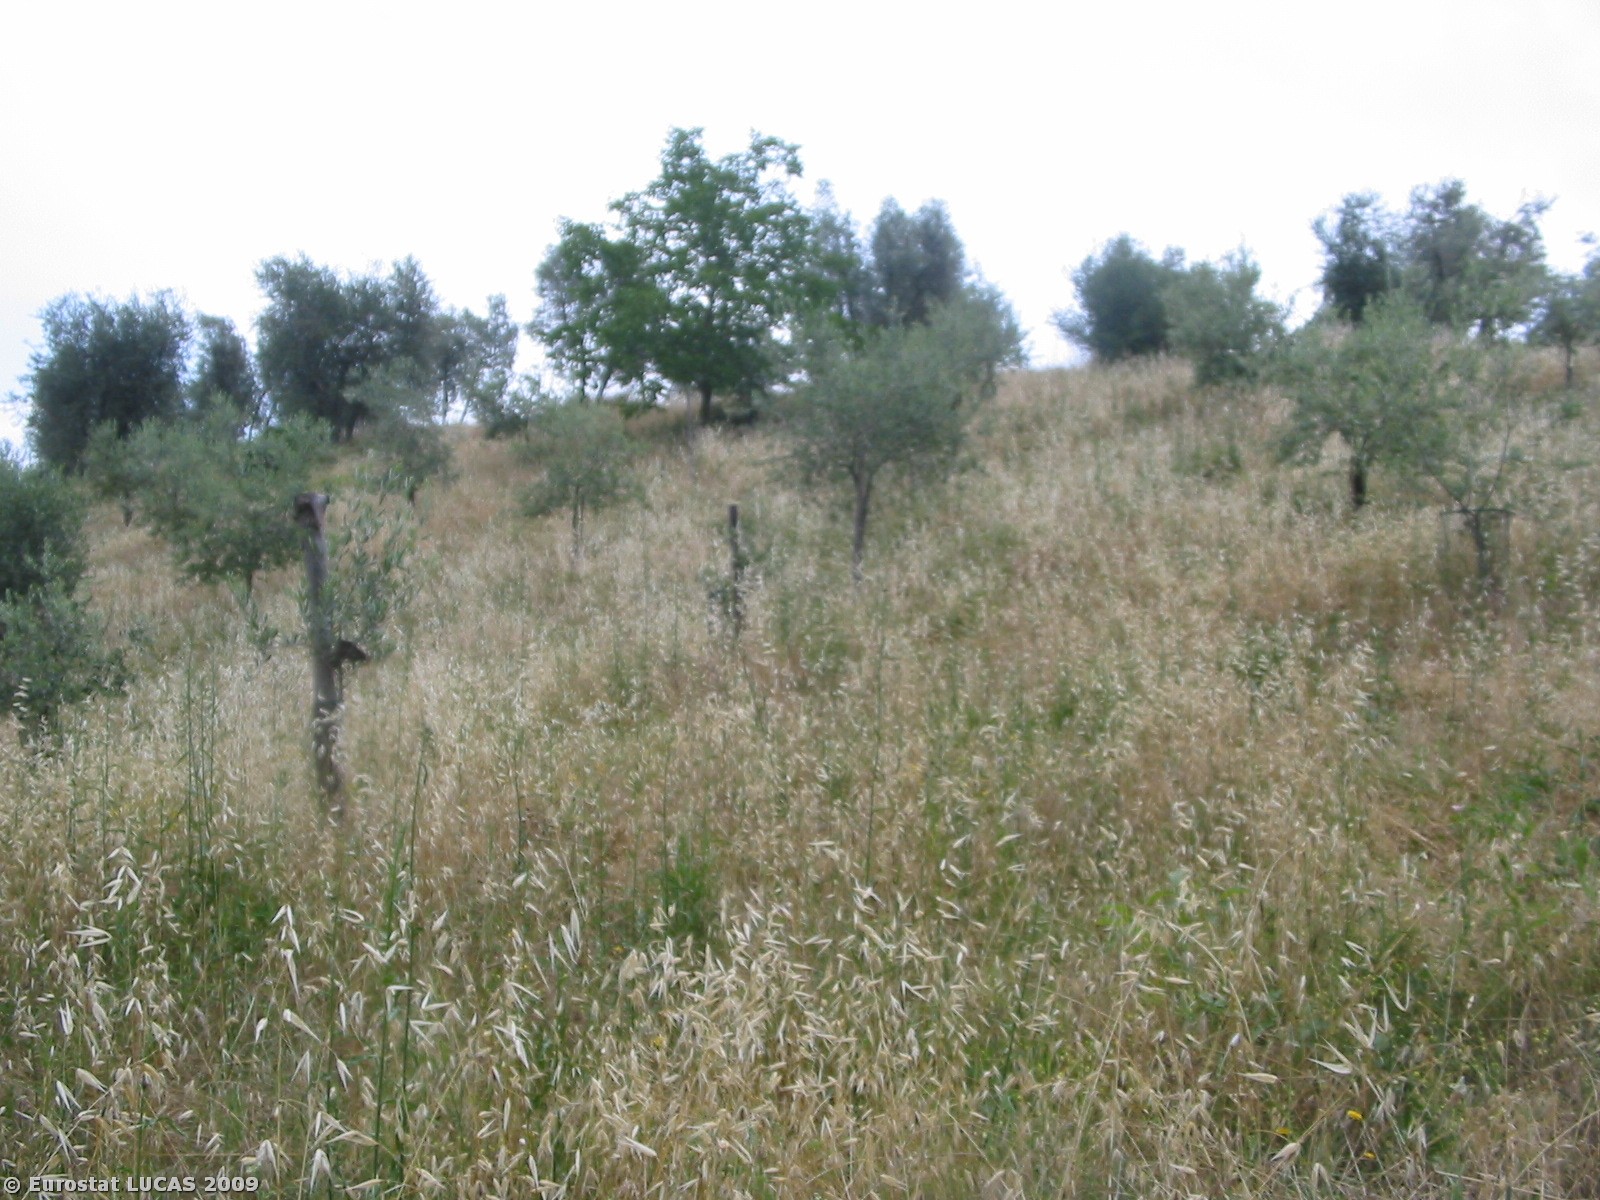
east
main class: Shrubland
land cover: Shrubland with sparse tree cover
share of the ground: > 75 %
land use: Unused
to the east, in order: Shrubland with sparse tree cover; Olive groves; Grassland with sparse tree/shrub cover; Abandoned hedges; Ditches and canals; Paved roads, cycling and walking lanes; Grass margins; Broadleaved woodland
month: June
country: IT
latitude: 43.1462
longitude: 11.6550
